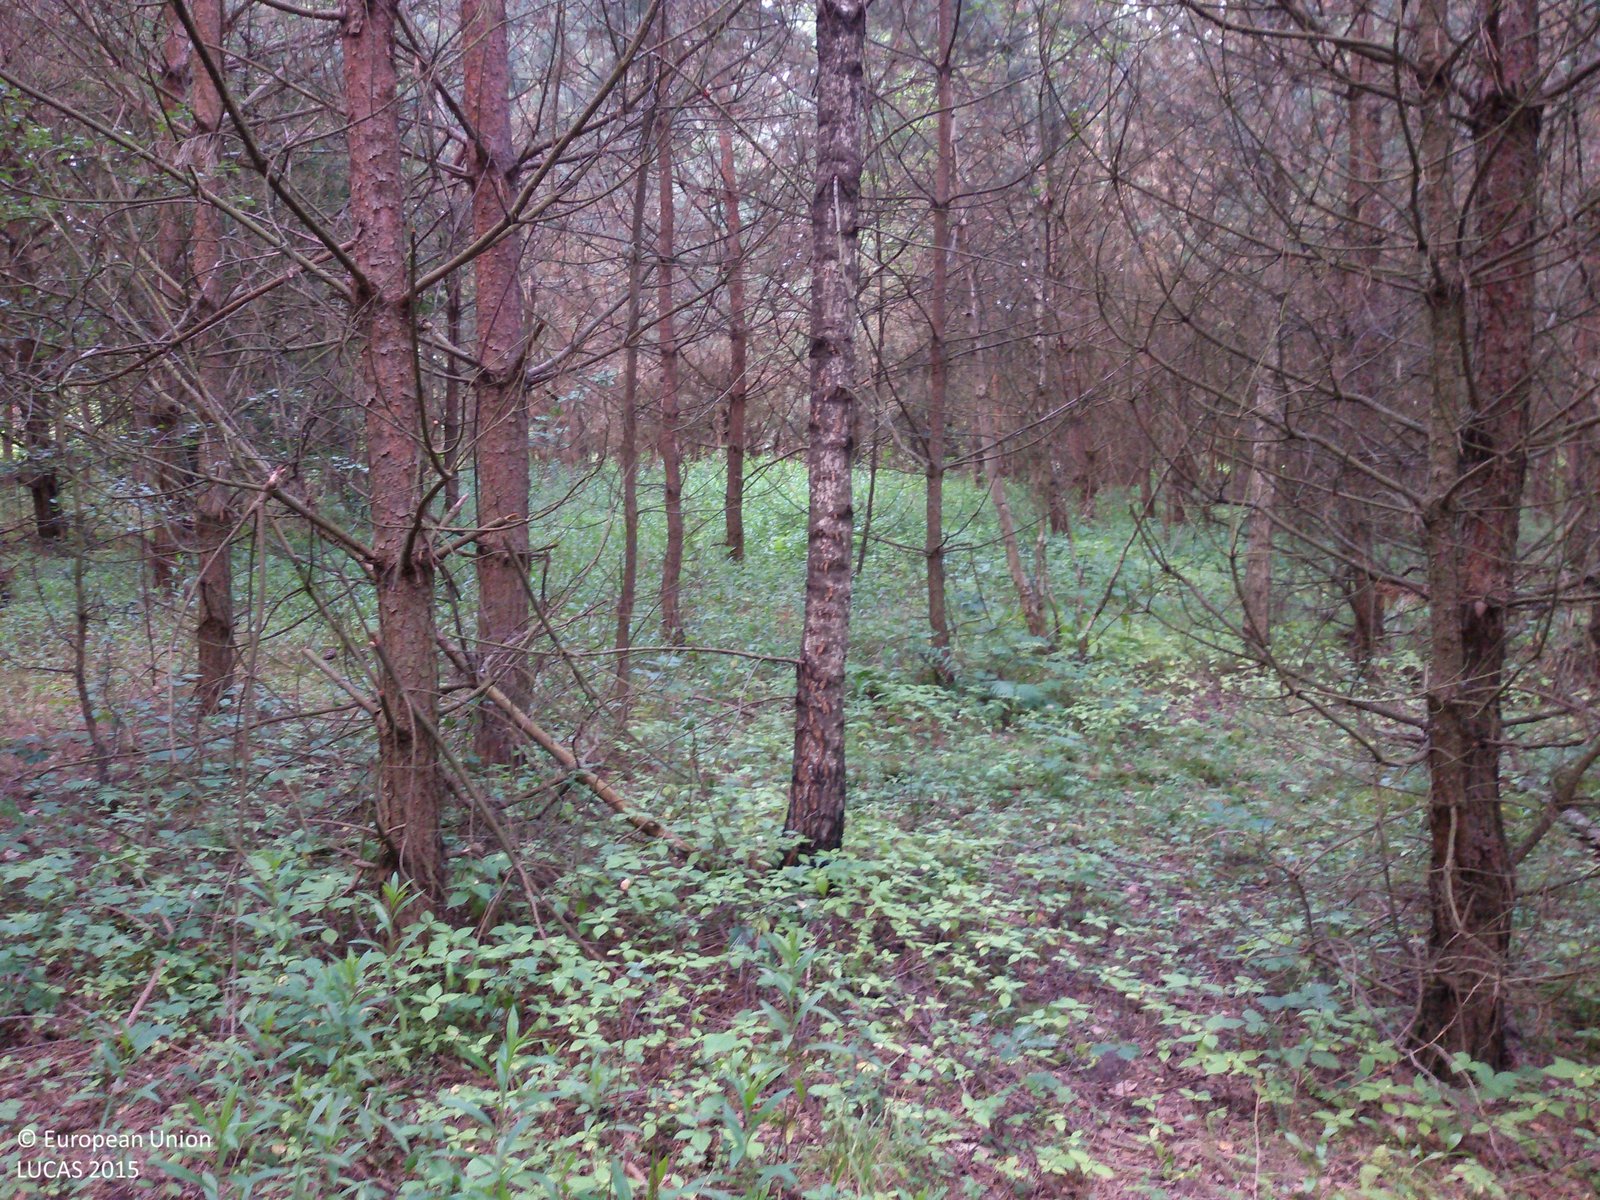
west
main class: Woodland
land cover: Pine dominated coniferous woodland
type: hemiboreal forest and nemoral coniferous forest and mixed broadleaved-coniferous forest
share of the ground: > 75 %
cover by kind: coniferous forest trees 90 %, herbaceous plants 10 %
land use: Forestry
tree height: > 5 m
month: June
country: PL
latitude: 50.8826
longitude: 21.7525
